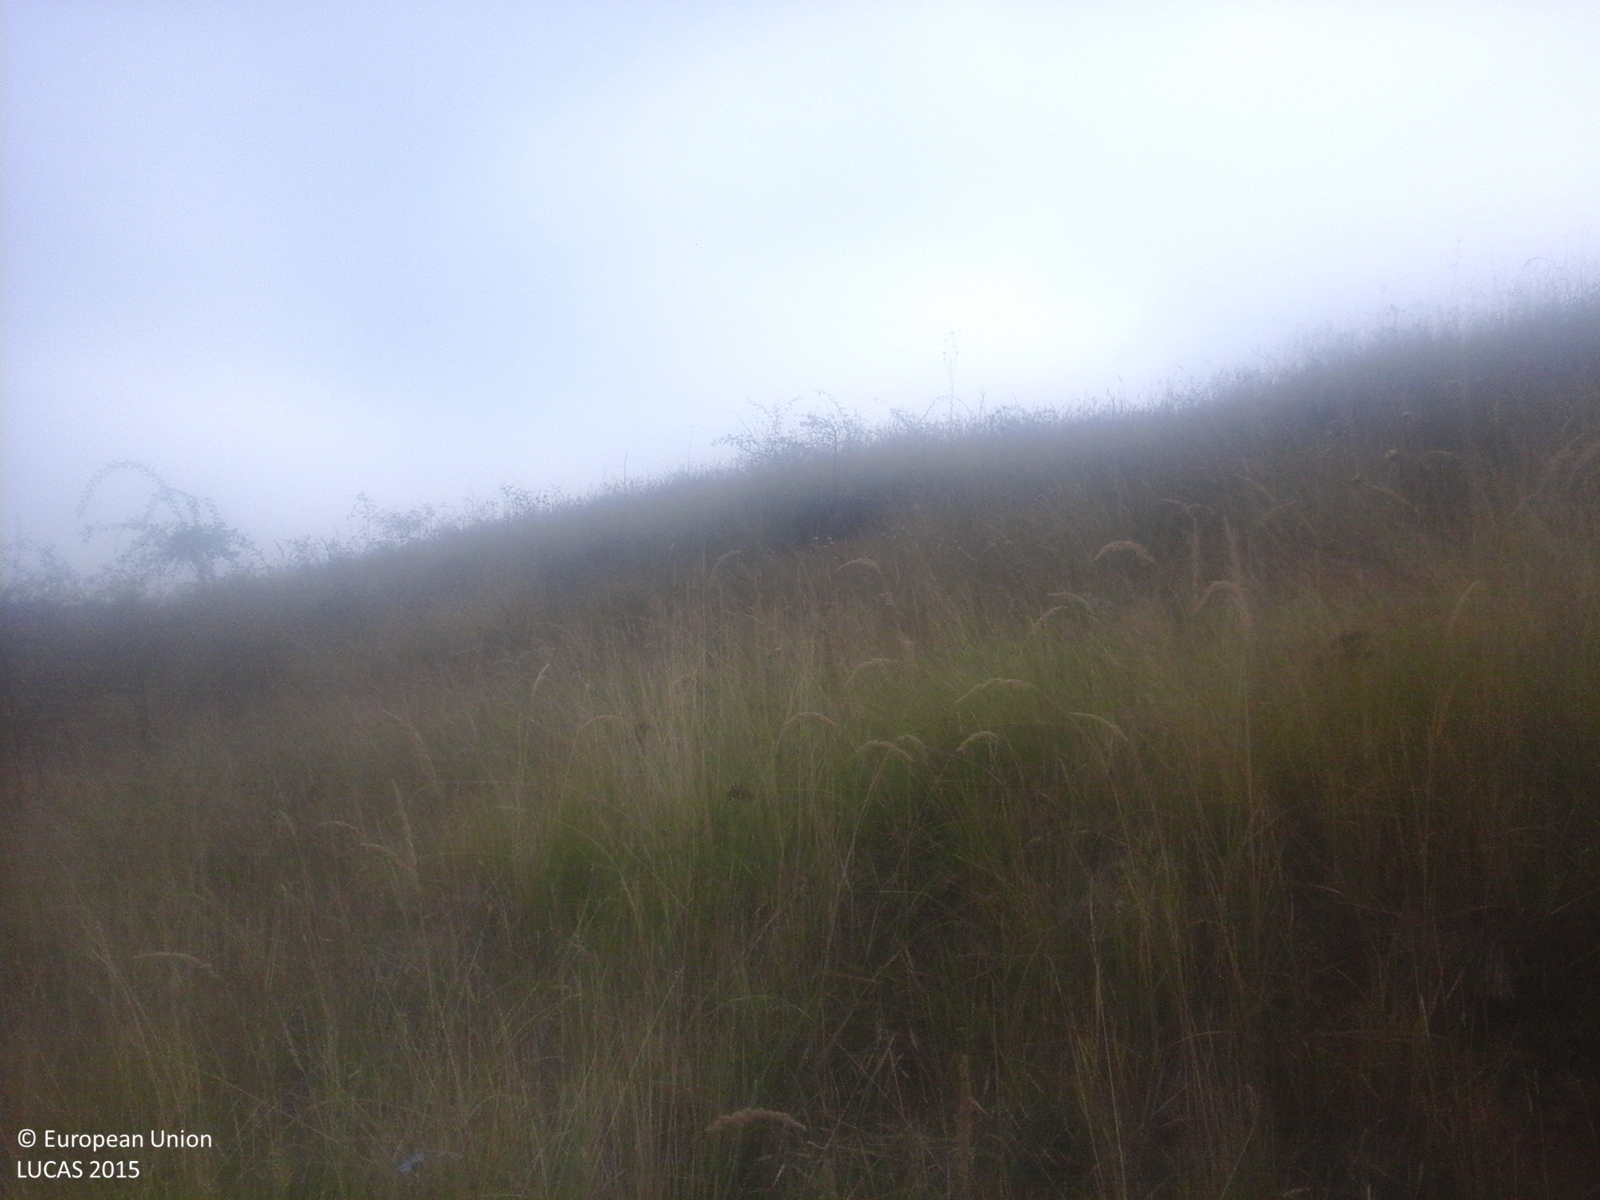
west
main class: Grassland
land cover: Spontaneously vegetated surfaces
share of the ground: > 75 %
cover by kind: herbaceous plants 100 %
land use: Fallow land
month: September
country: RO
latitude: 44.7446
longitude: 23.1981
